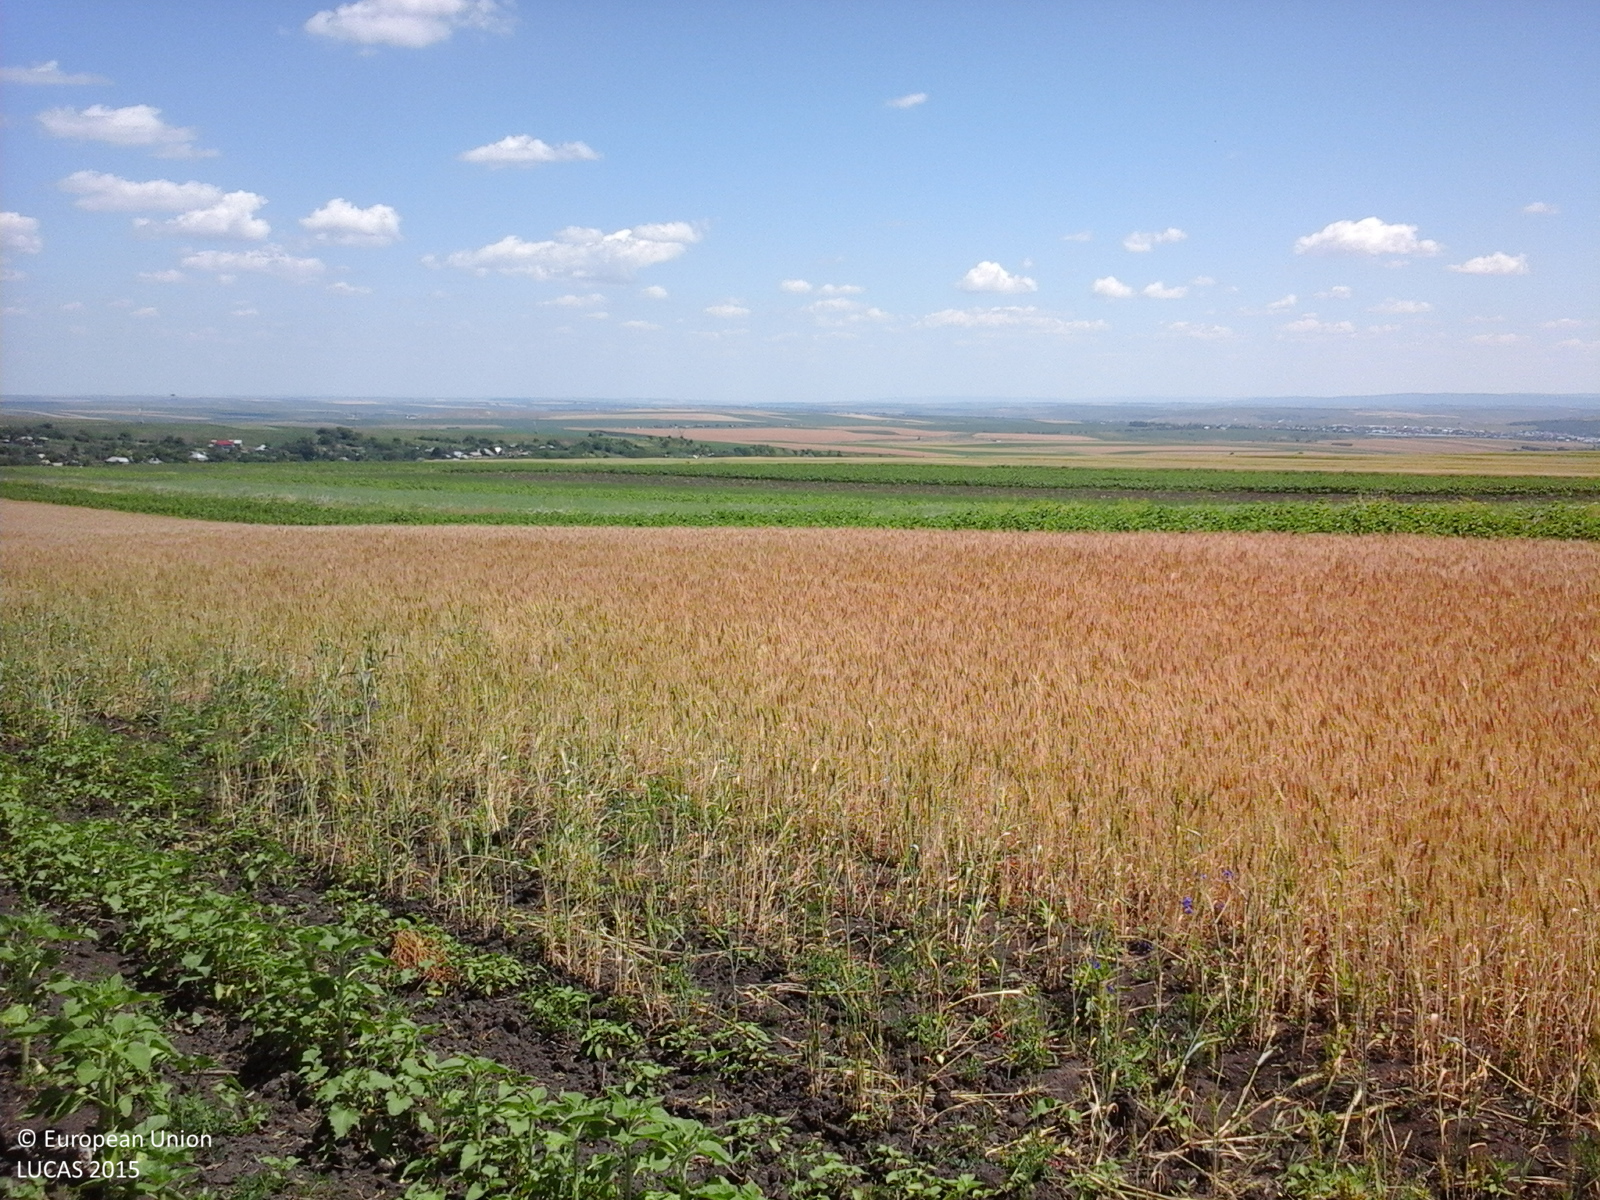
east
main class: Cropland
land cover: Sunflower
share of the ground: > 75 %
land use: Agriculture (excluding fallow land and kitchen gardens)
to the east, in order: Sunflower; Common wheat; Sunflower; Spontaneously vegetated surfaces; Oats; Soya; Grass margins; Lucerne; Other bare soil; Sunflower
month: June
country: RO
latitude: 47.2522
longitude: 26.9196
